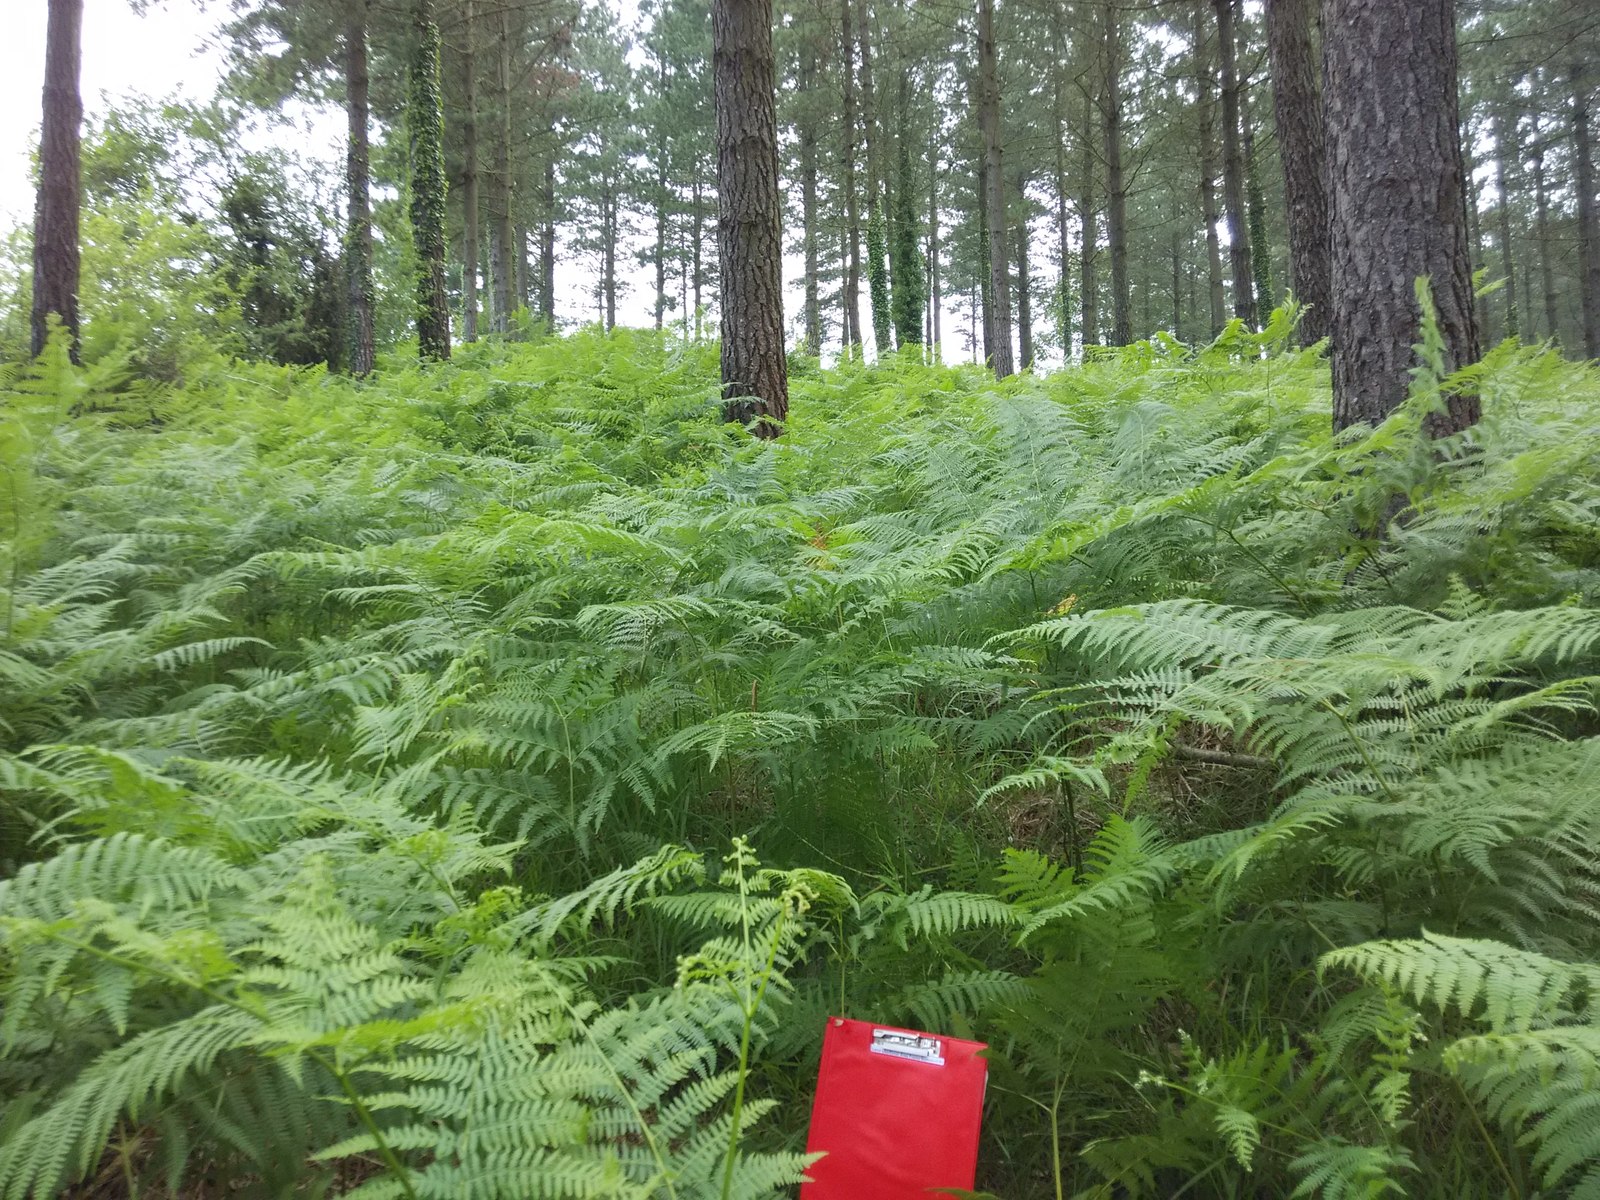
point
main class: Woodland
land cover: Pine dominated coniferous woodland
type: exotic forest
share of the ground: > 75 %
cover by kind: coniferous forest trees 85 %, shrubs 15 %
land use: Forestry
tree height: > 5 m
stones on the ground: < 10 %
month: June
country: ES
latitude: 43.2029
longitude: -2.5449
